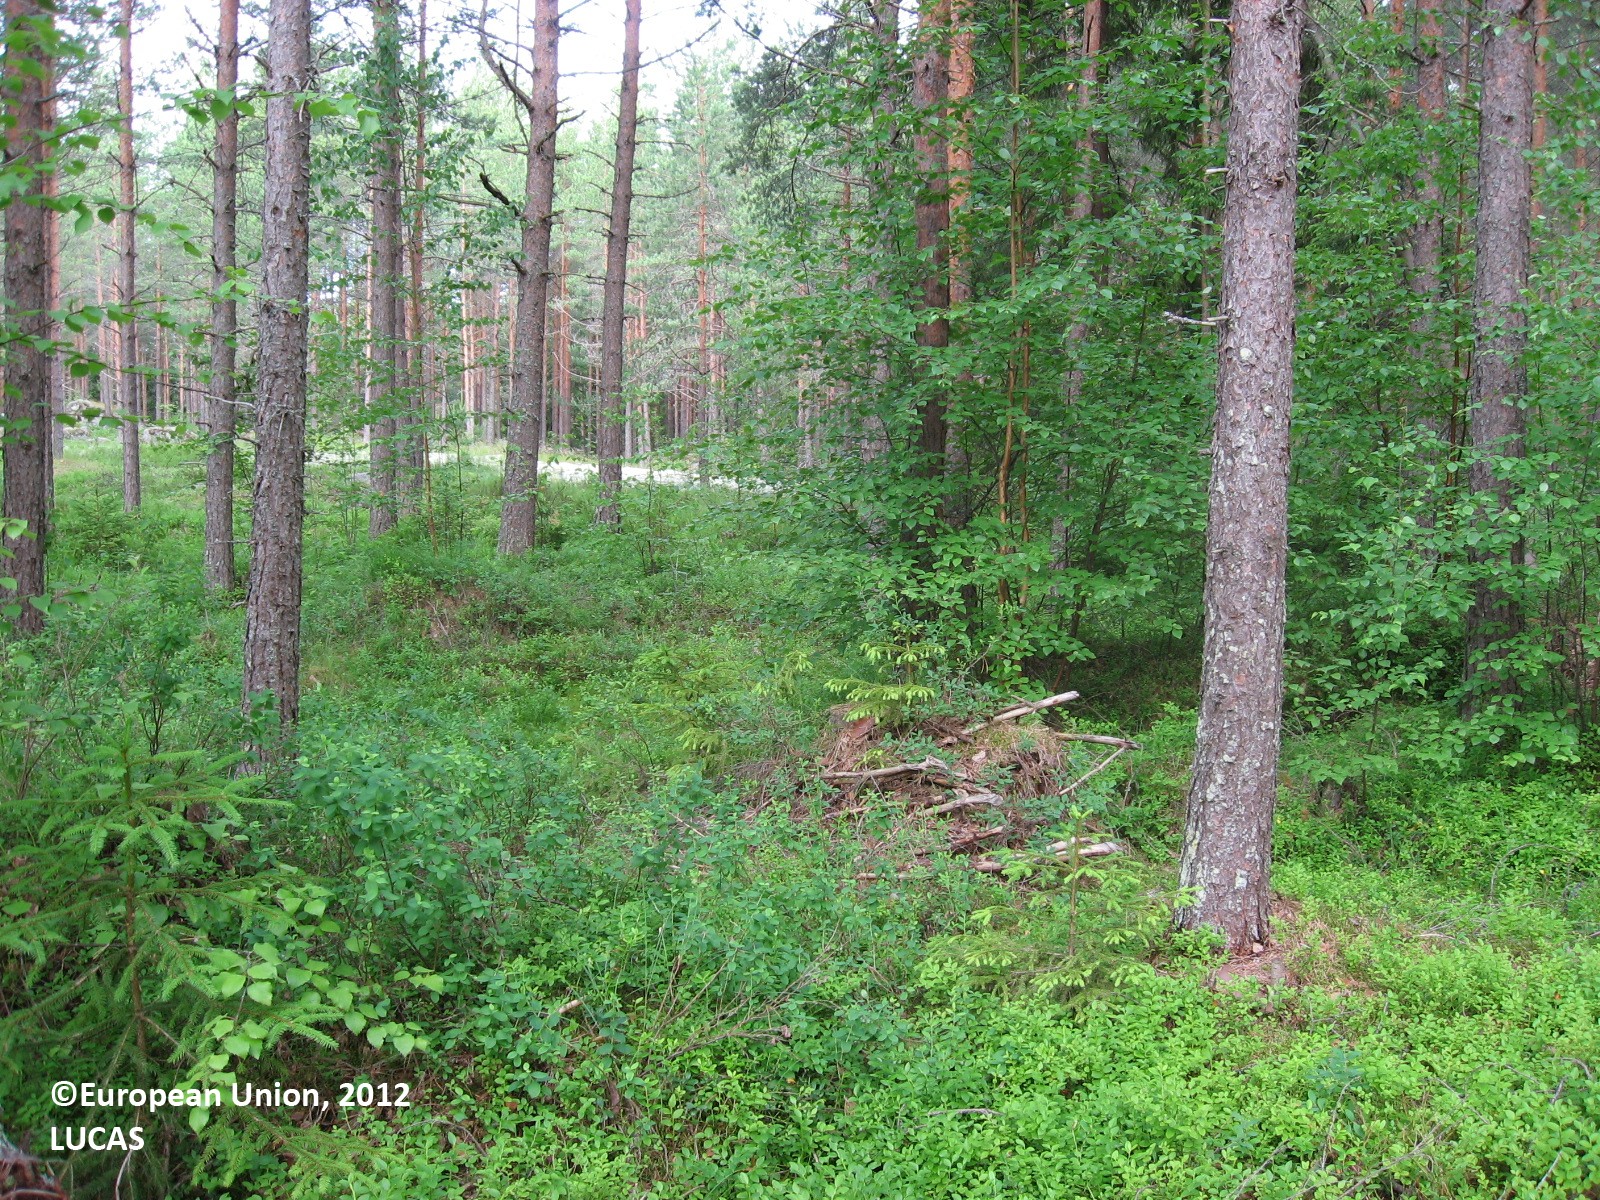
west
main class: Woodland
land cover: Pine dominated coniferous woodland
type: boreal forest
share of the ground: 50 - 75 %
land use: Forestry
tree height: > 5 m
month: June
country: FI
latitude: 60.6559
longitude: 26.1894
